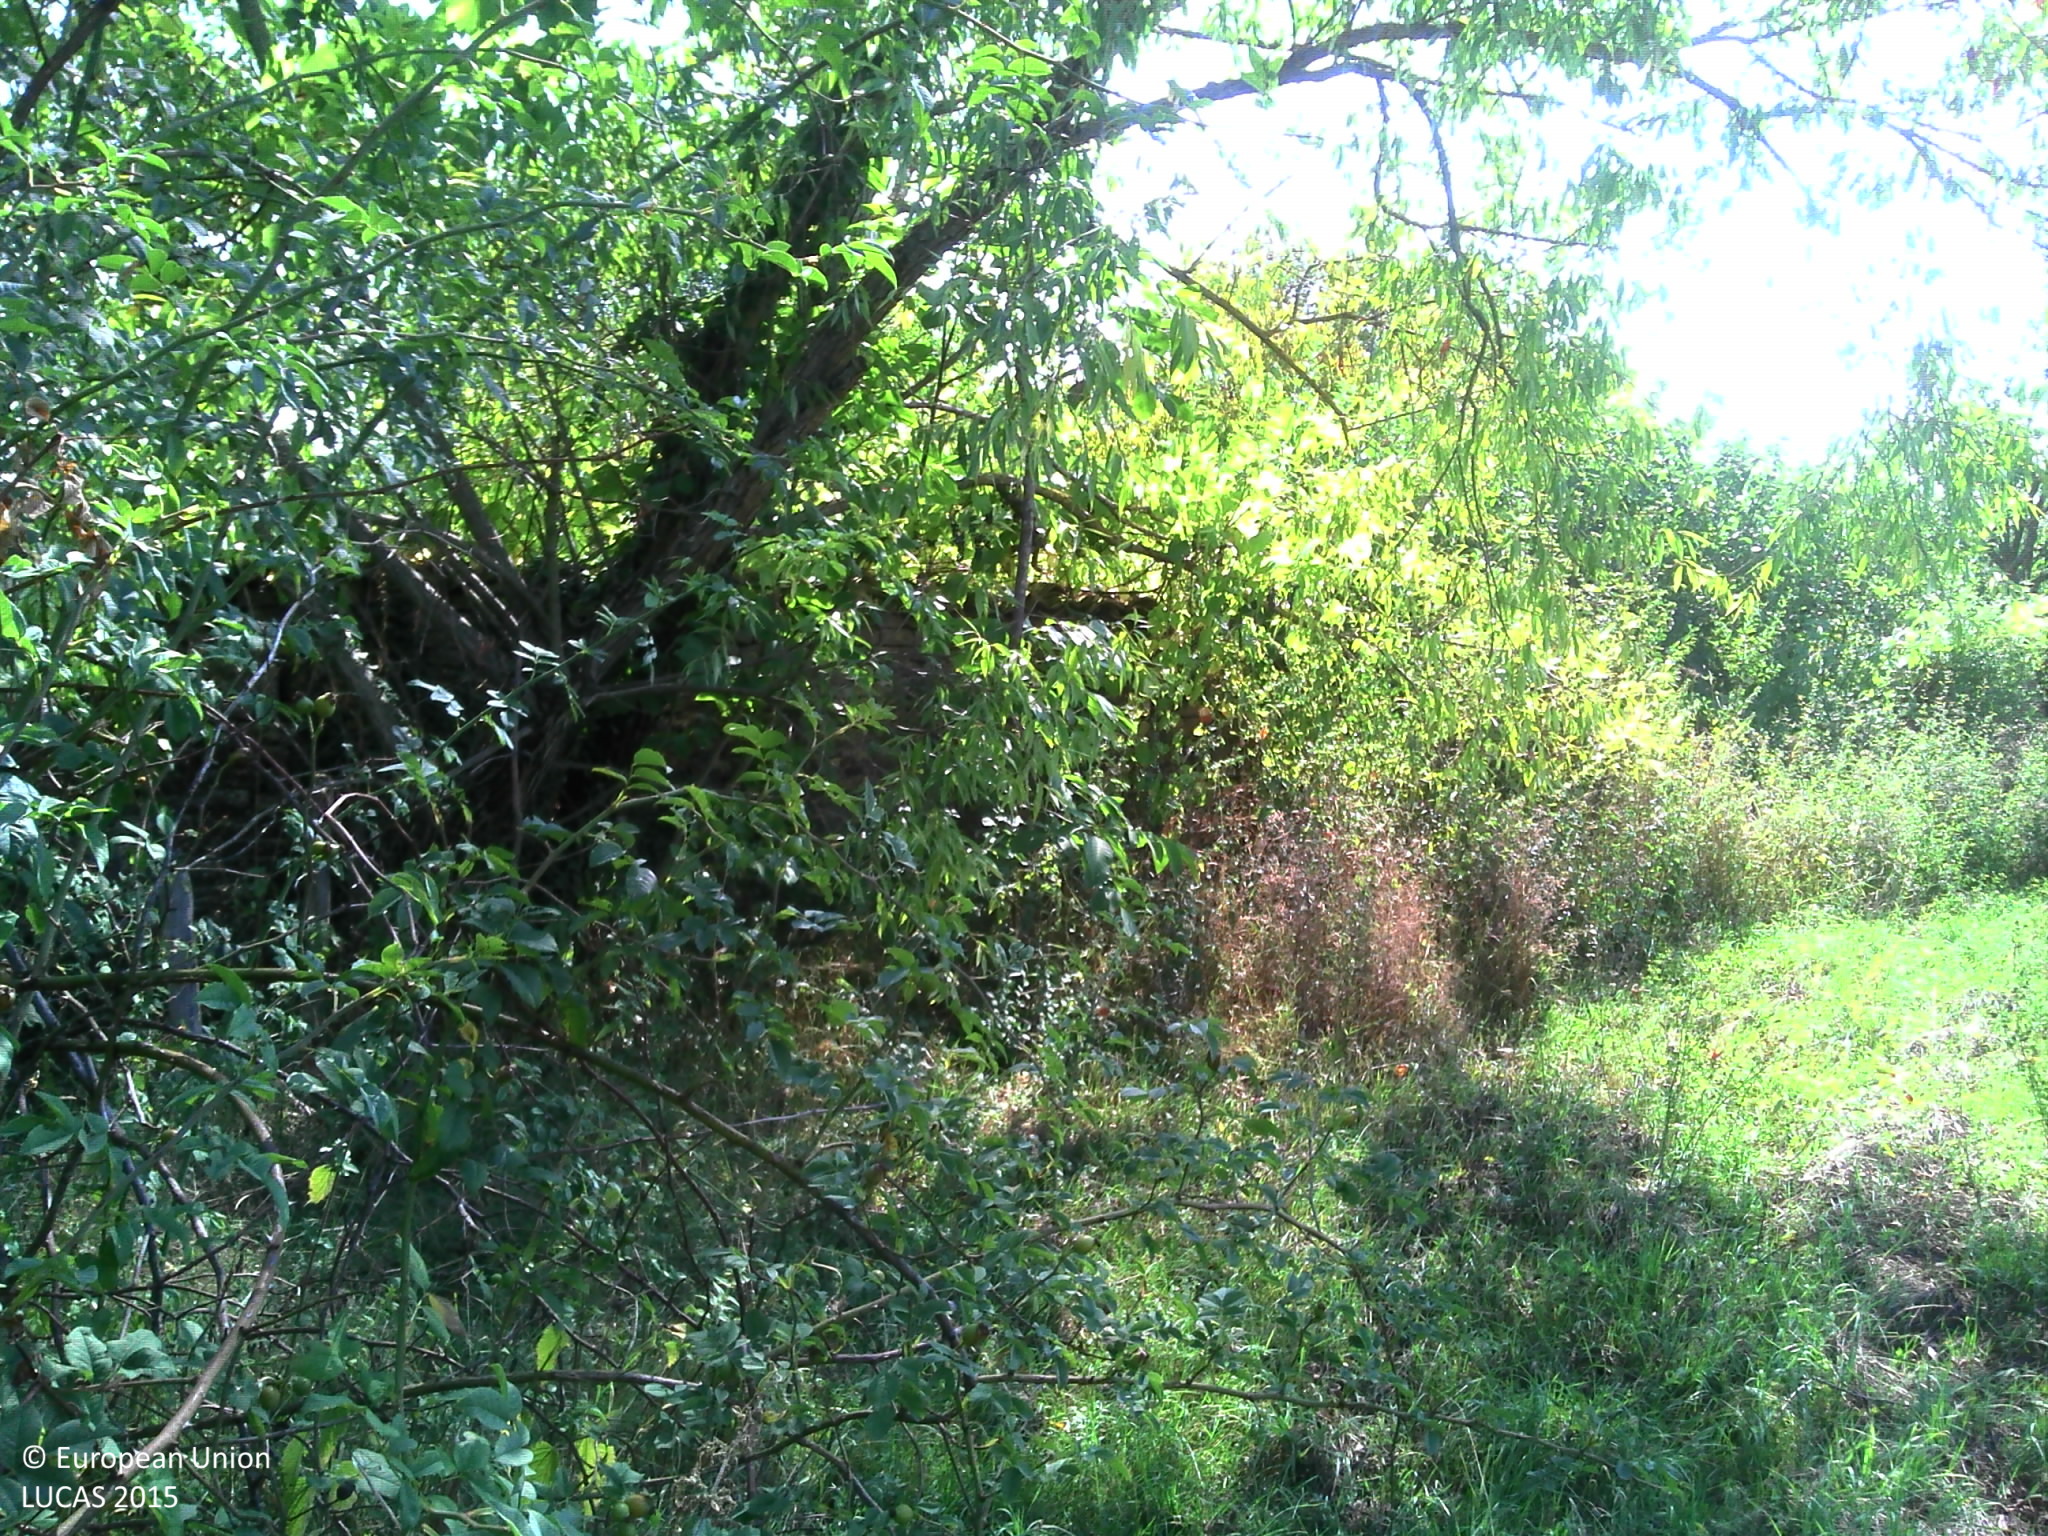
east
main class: Cropland
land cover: Apple fruit
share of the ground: > 75 %
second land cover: Grassland without tree/shrub cover
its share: > 75 %
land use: Kitchen garden
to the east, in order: Fences; Abandoned hedges; Dry stone walls; Grassland with sparse tree/shrub cover; Artificial constructions in urban areas; Grassland without tree/shrub cover; Artificial constructions in urban areas; Single bushes/trees; Fences; Grassland without tree/shrub cover
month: August
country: FR
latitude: 46.3327
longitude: 4.7930
